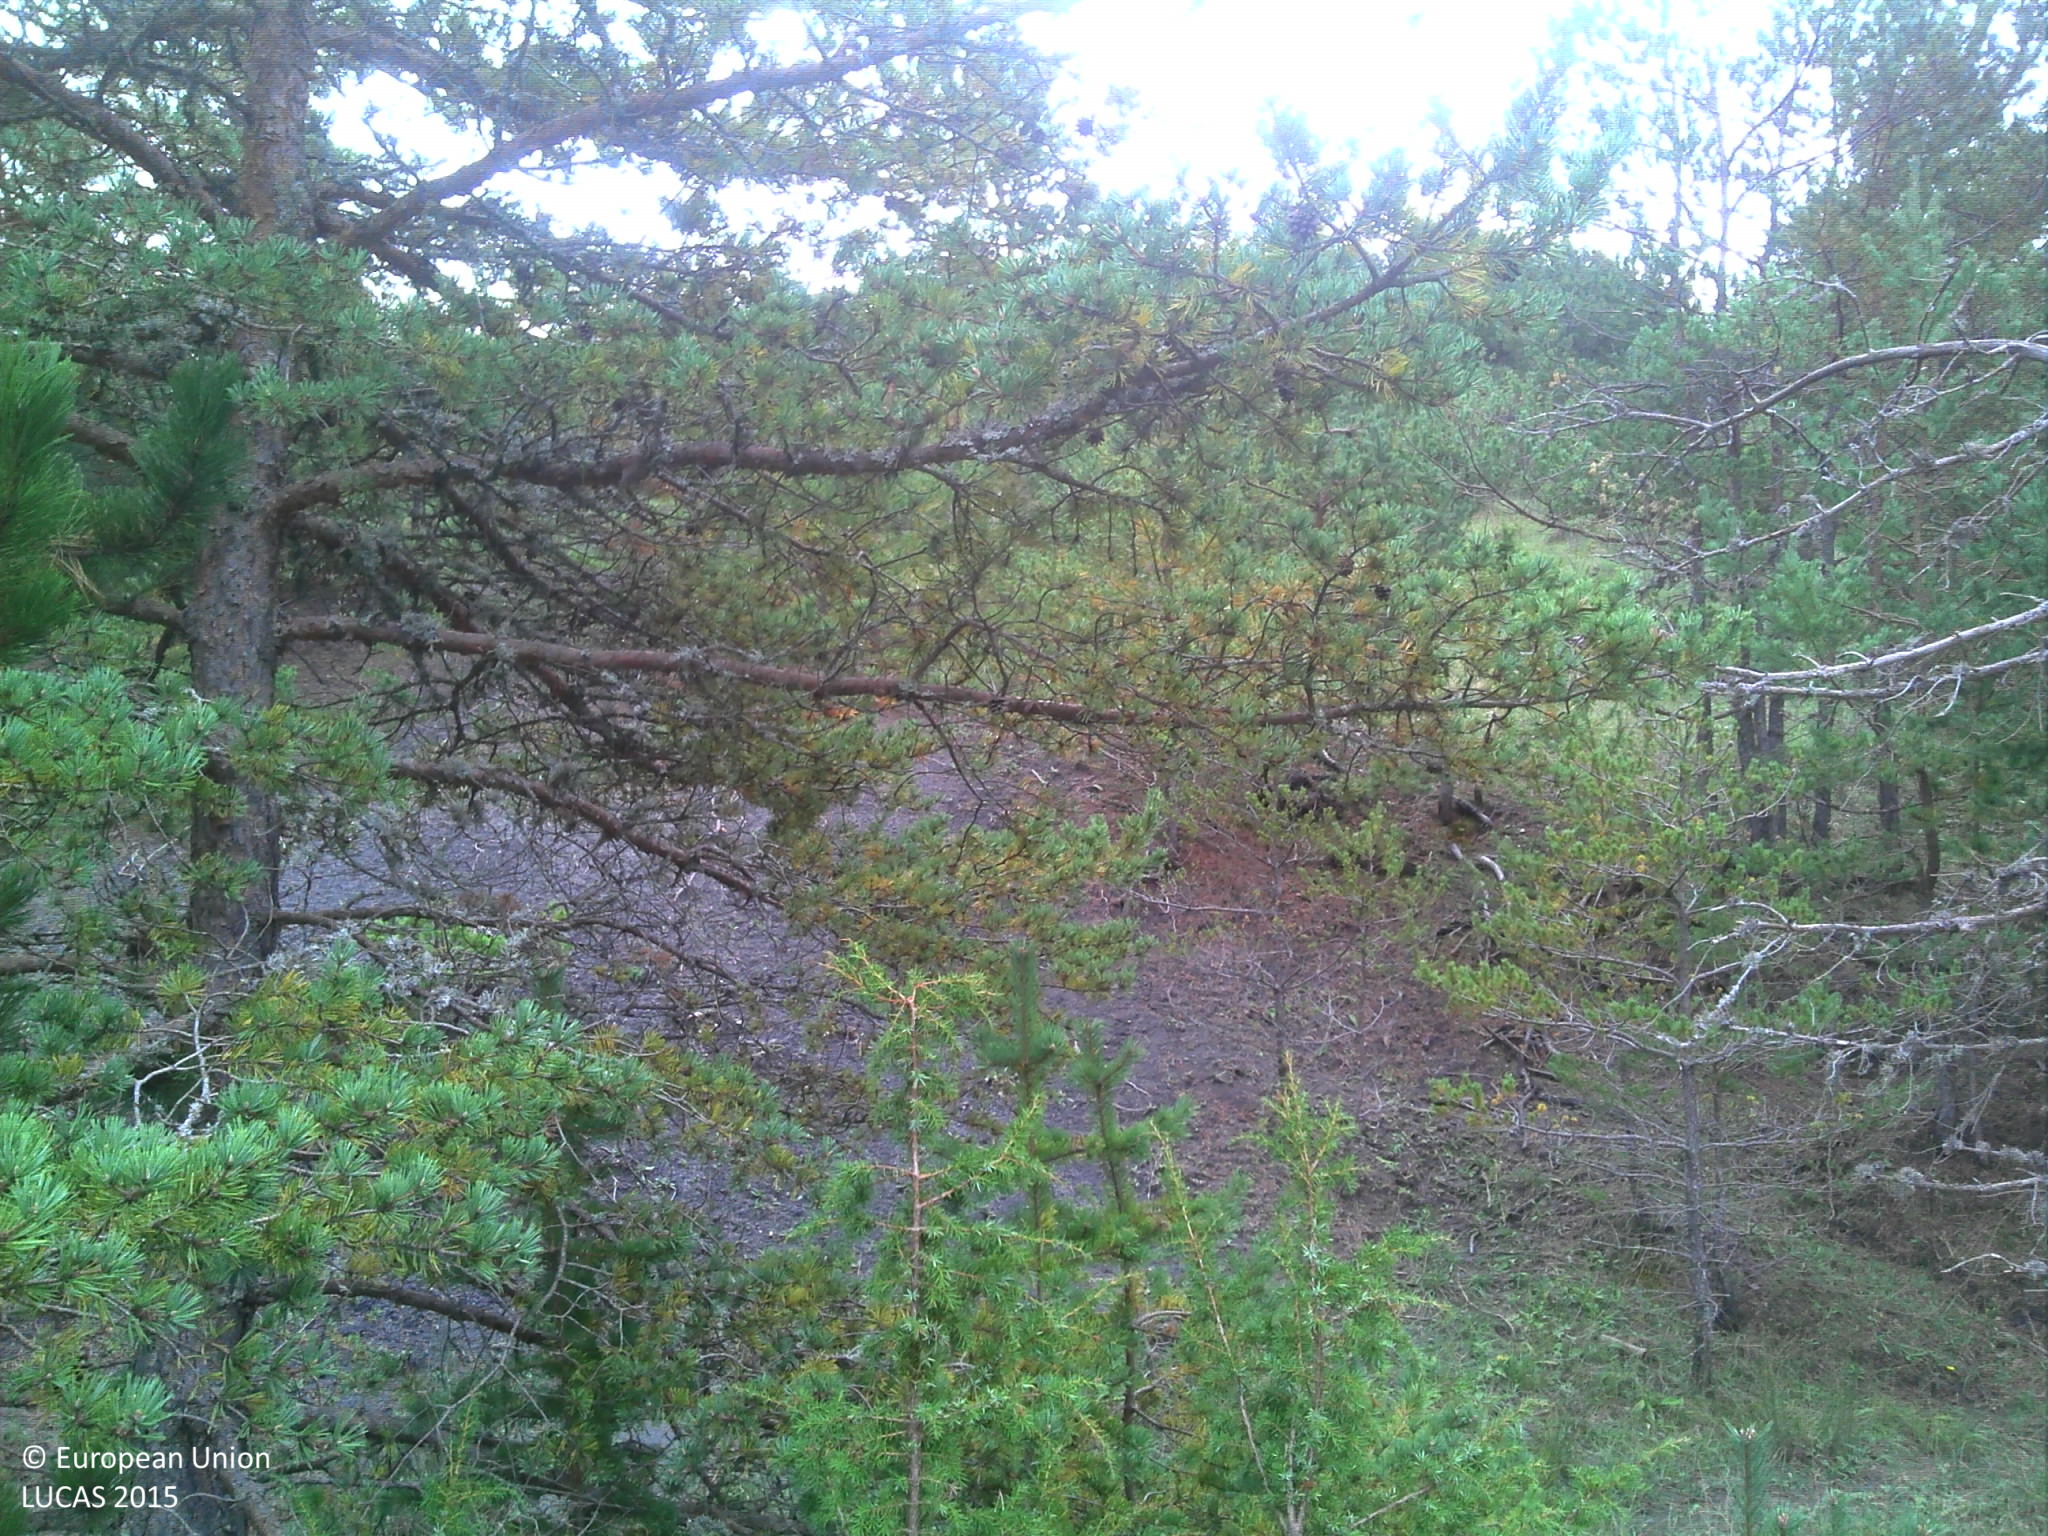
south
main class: Grassland
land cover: Grassland without tree/shrub cover
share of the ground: > 75 %
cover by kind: herbaceous plants 95 %, shrubs 5 %
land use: Agriculture (excluding fallow land and kitchen gardens)
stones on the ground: > 50 %
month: September
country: FR
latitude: 44.5055
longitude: 5.4914
